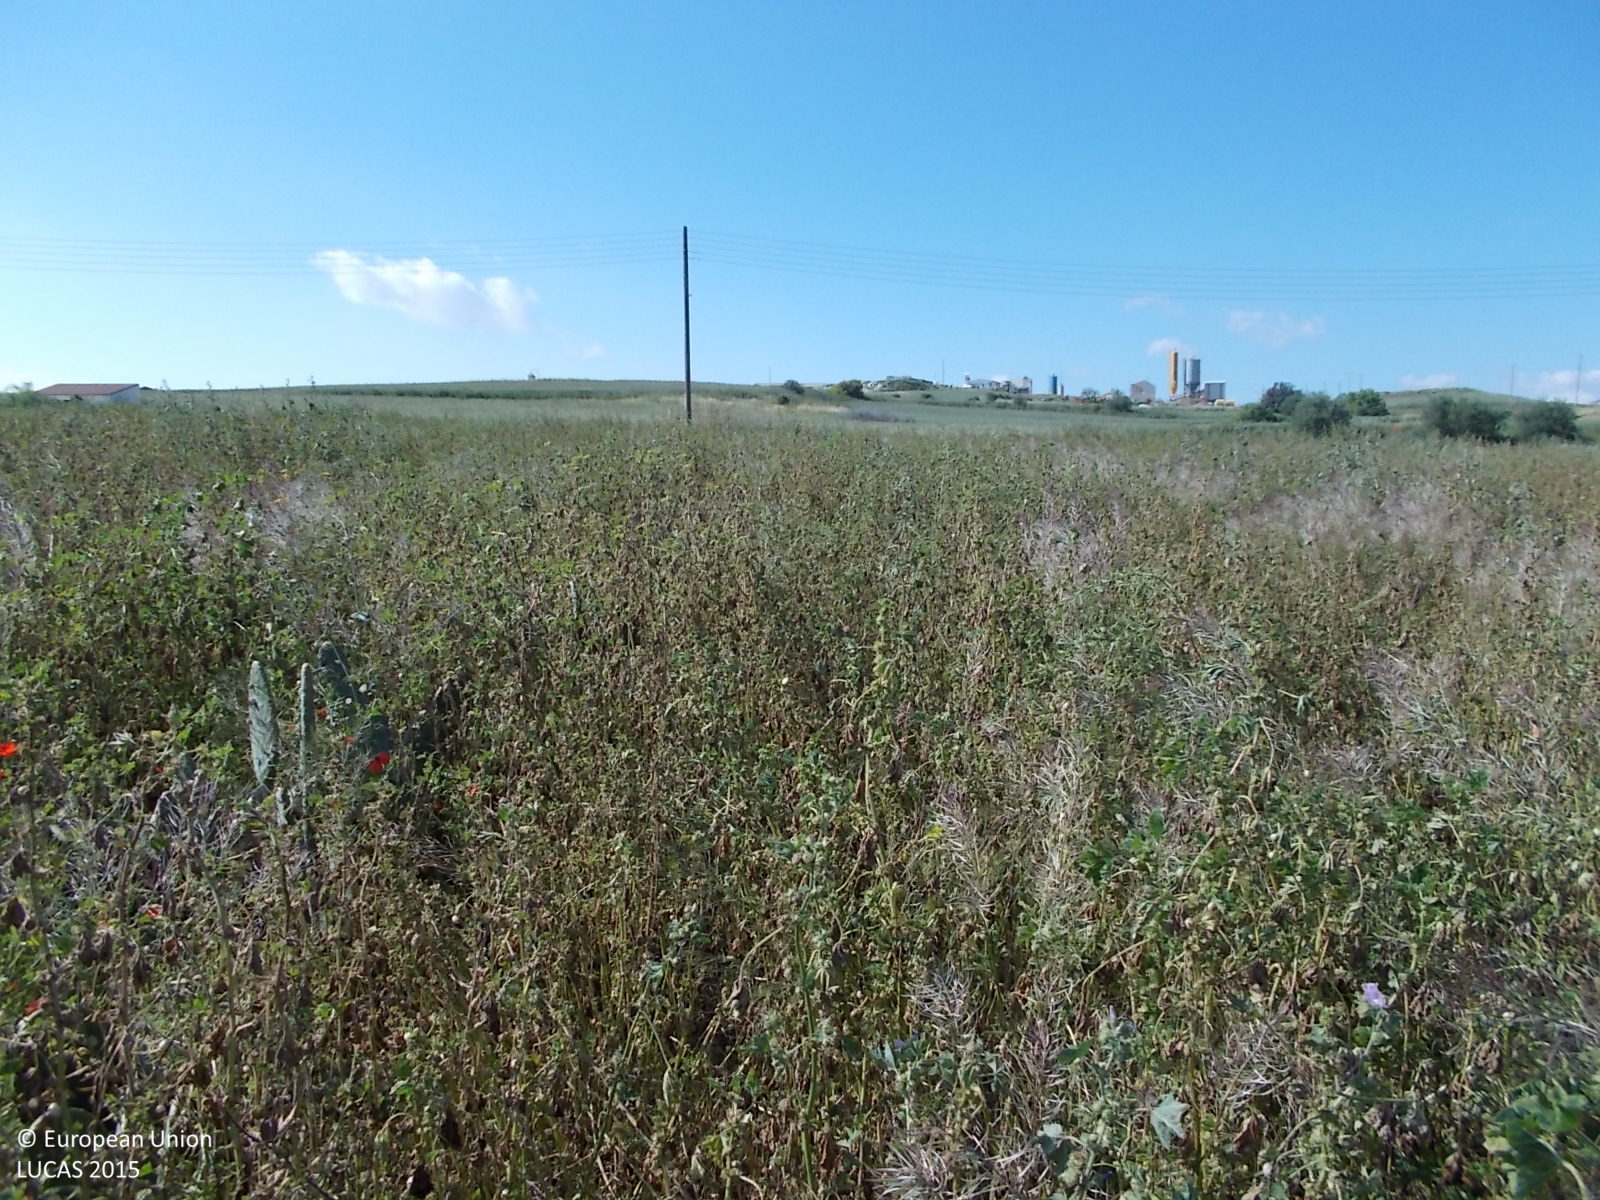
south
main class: Grassland
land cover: Spontaneously vegetated surfaces
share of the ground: > 75 %
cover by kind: herbaceous plants 100 %
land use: Fallow land
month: April
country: CY
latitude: 35.0489
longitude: 33.5380
